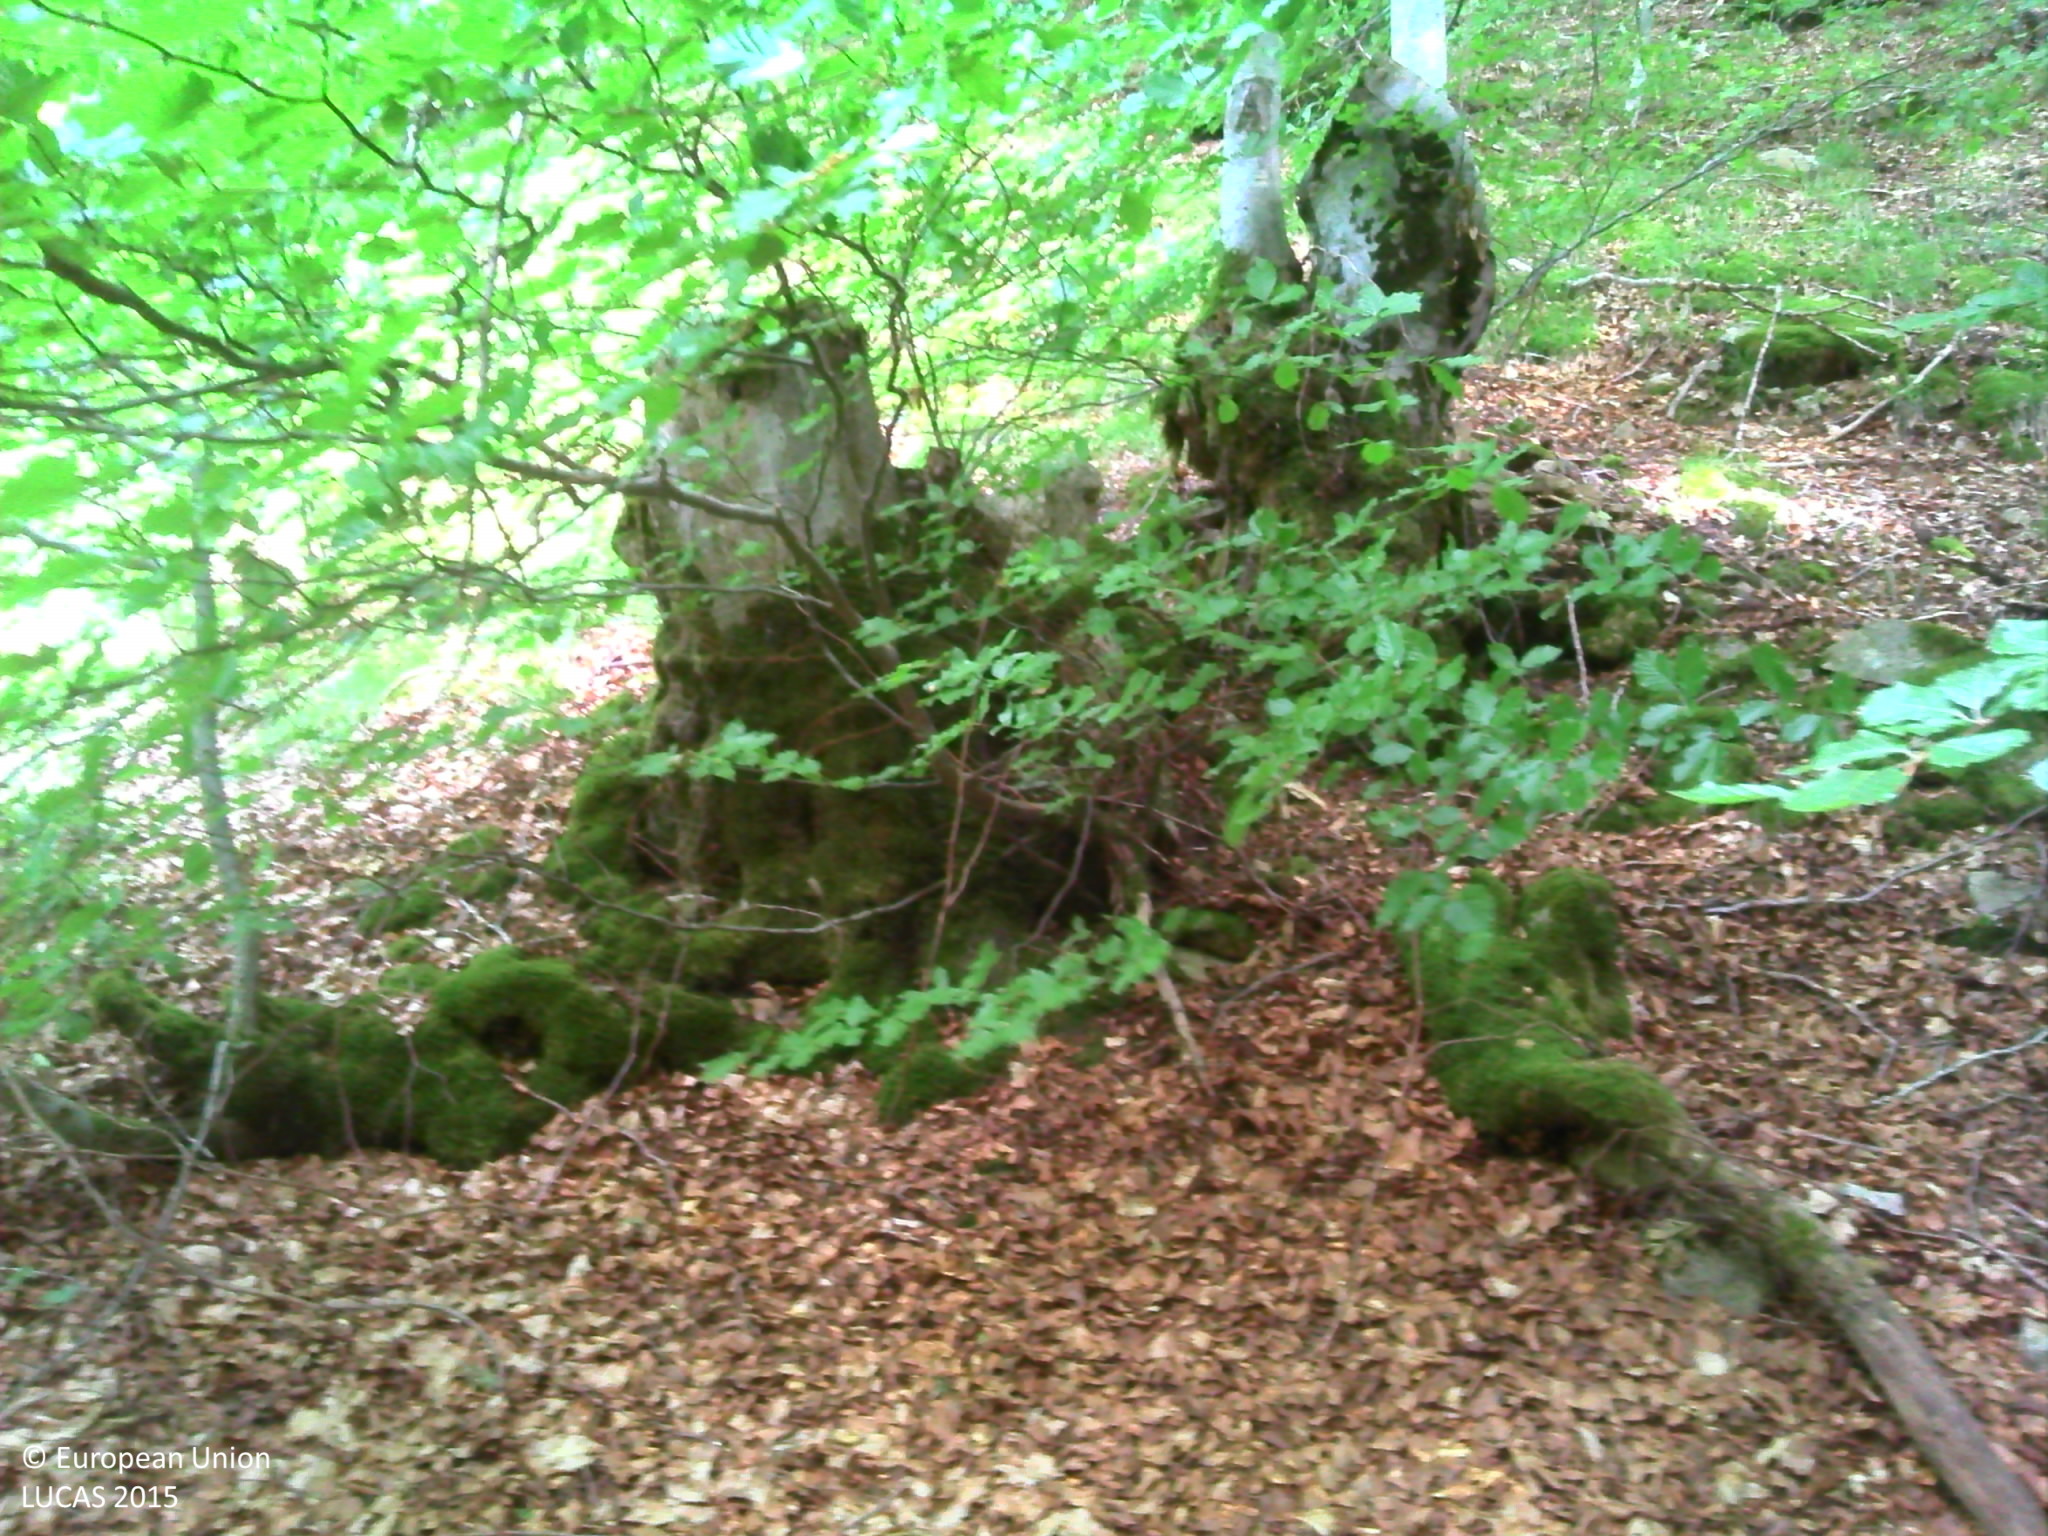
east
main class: Woodland
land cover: Broadleaved woodland
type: beech forest
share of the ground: > 75 %
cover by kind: broadleaved forest trees 95 %, coniferous forest trees 5 %
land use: Forestry
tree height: > 5 m
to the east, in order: Broadleaved woodland; Fences; Spruce dominated coniferous woodland; Broadleaved woodland; Fences; Grass margins; Railways
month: June
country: FR
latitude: 44.5673
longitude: 3.8737
